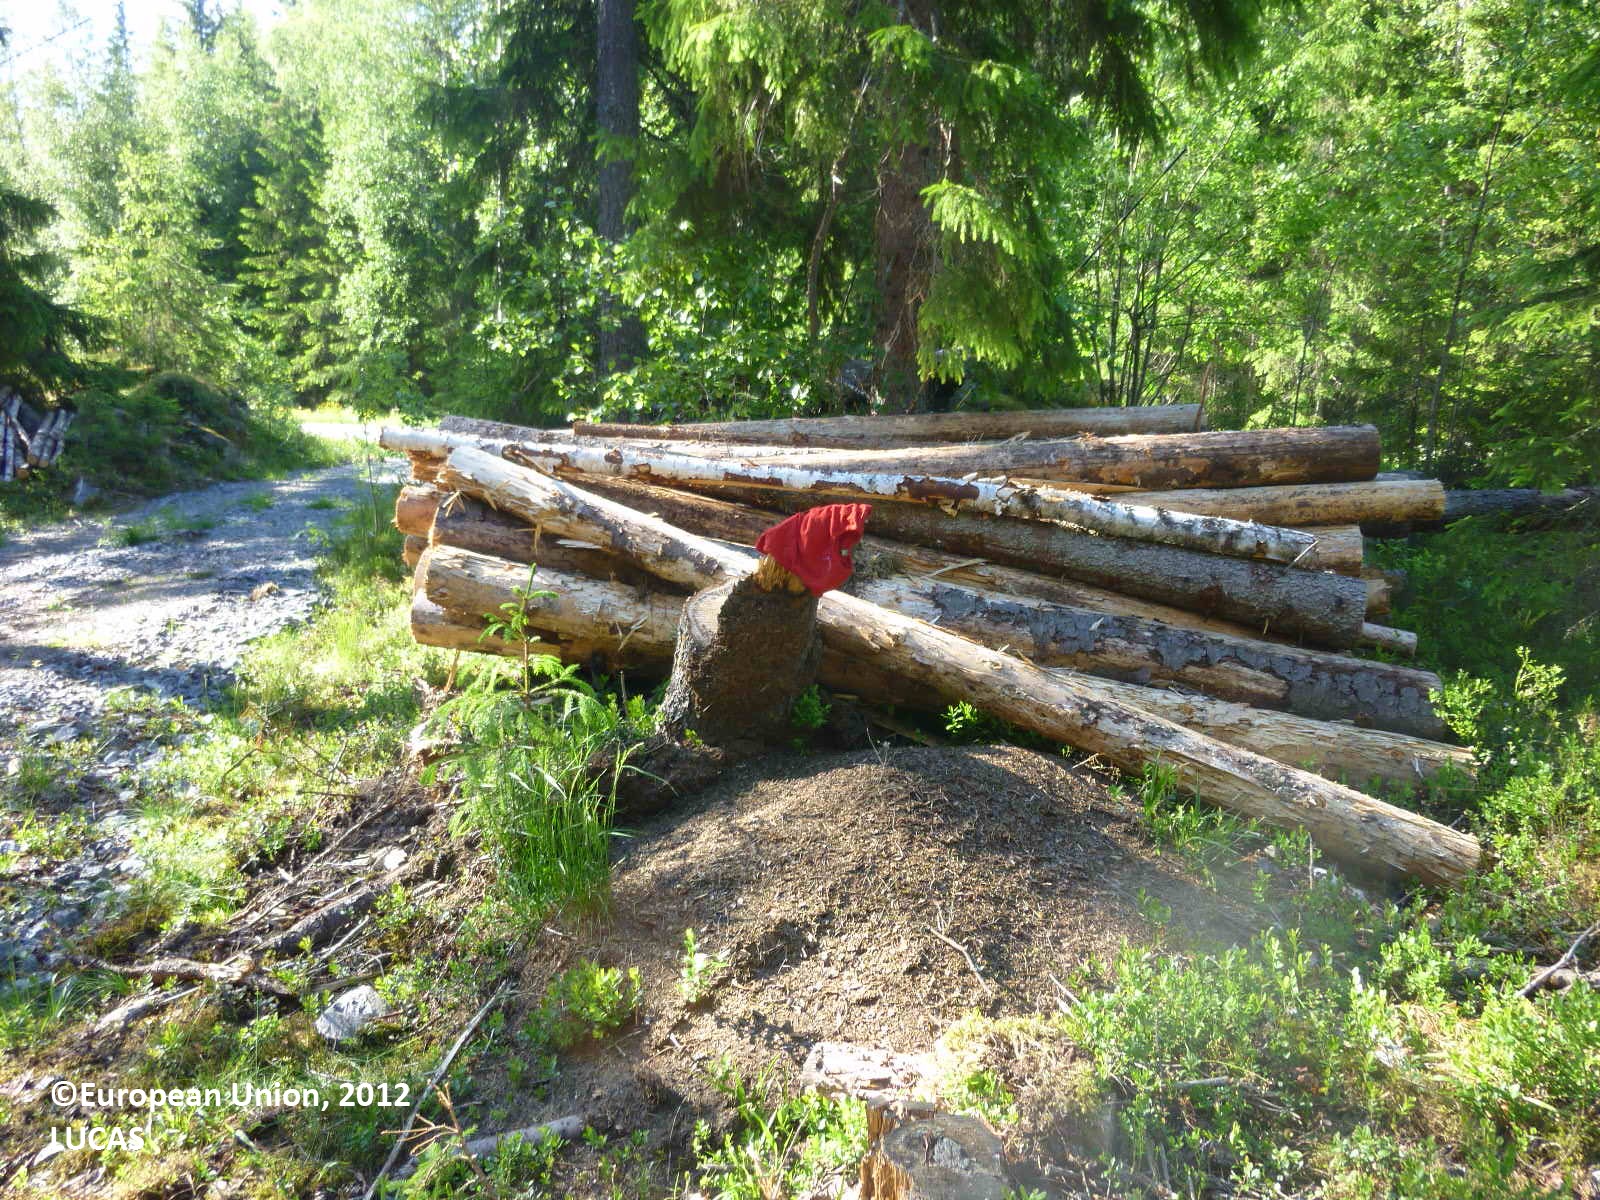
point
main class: Woodland
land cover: Spruce dominated coniferous woodland
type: boreal forest
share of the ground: > 75 %
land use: Forestry
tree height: > 5 m
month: June
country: FI
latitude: 61.6719
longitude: 22.2433
